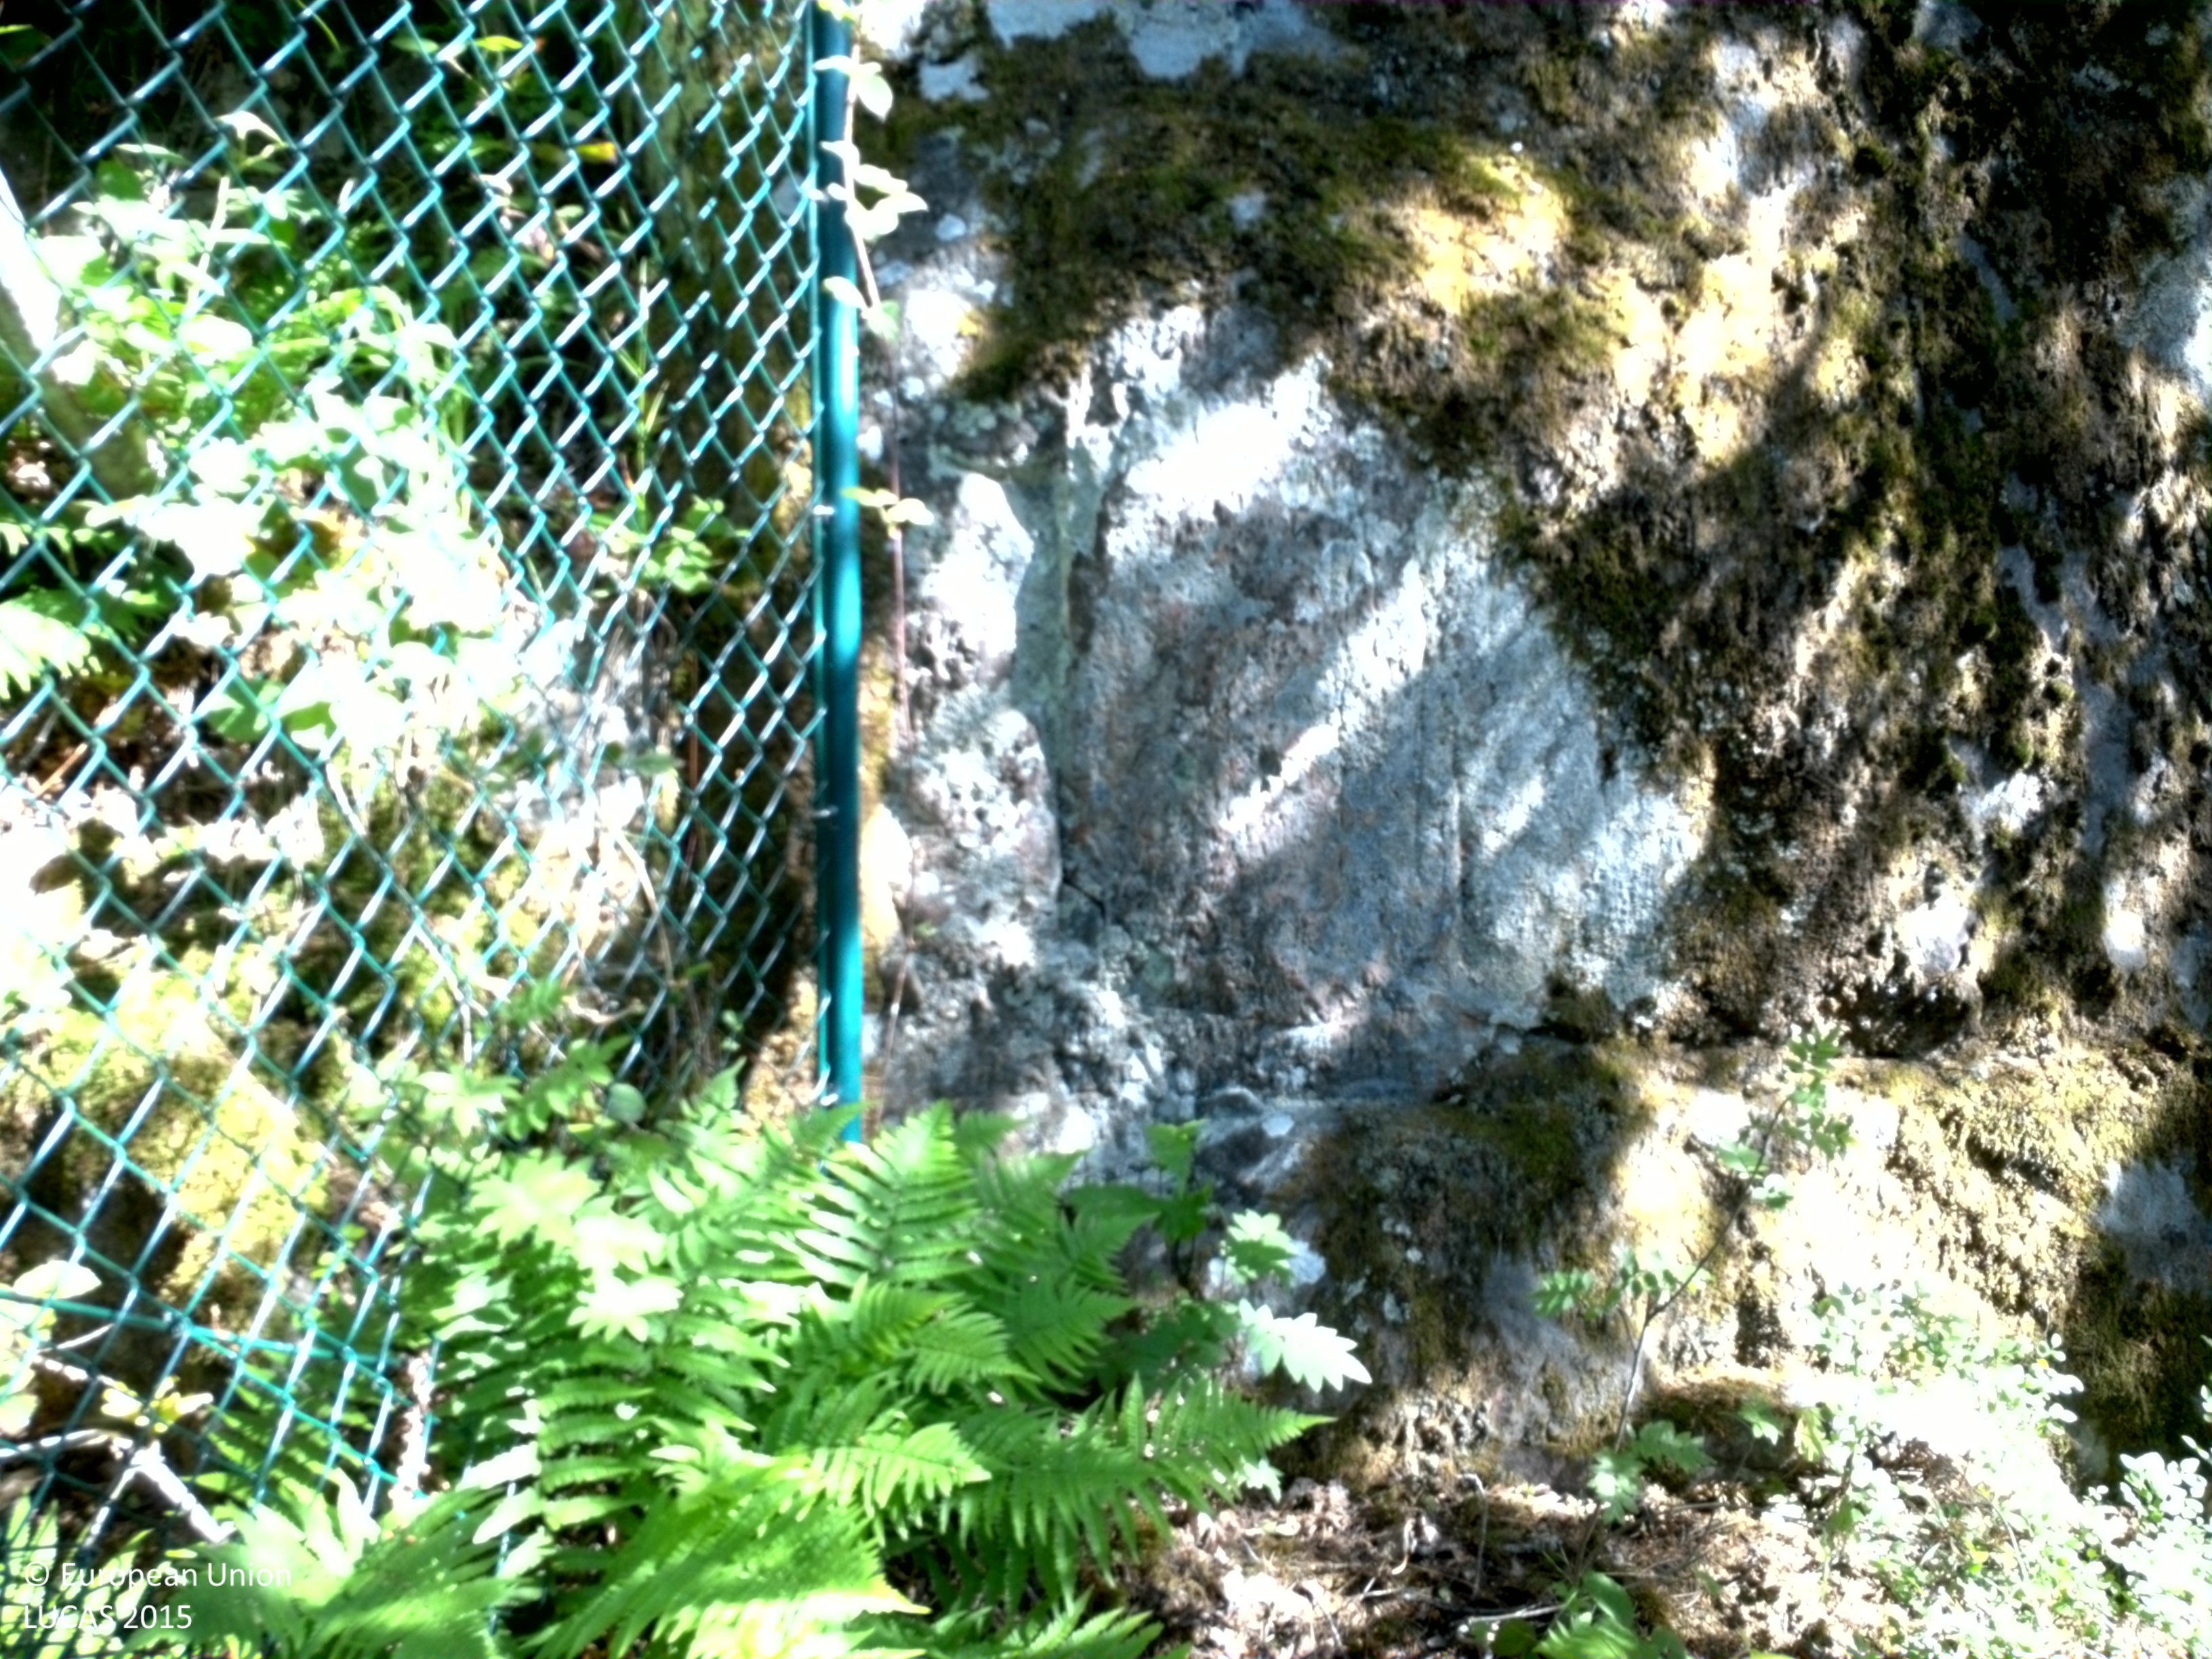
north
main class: Woodland
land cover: Spruce dominated mixed woodland
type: boreal forest
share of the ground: 50 - 75 %
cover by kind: coniferous forest trees 45 %, broadleaved forest trees 30 %, herbaceous plants 20 %, lichens and mosses 5 %
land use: Semi-natural and natural areas not in use
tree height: > 5 m
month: June
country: SE
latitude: 58.6600
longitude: 16.4596
